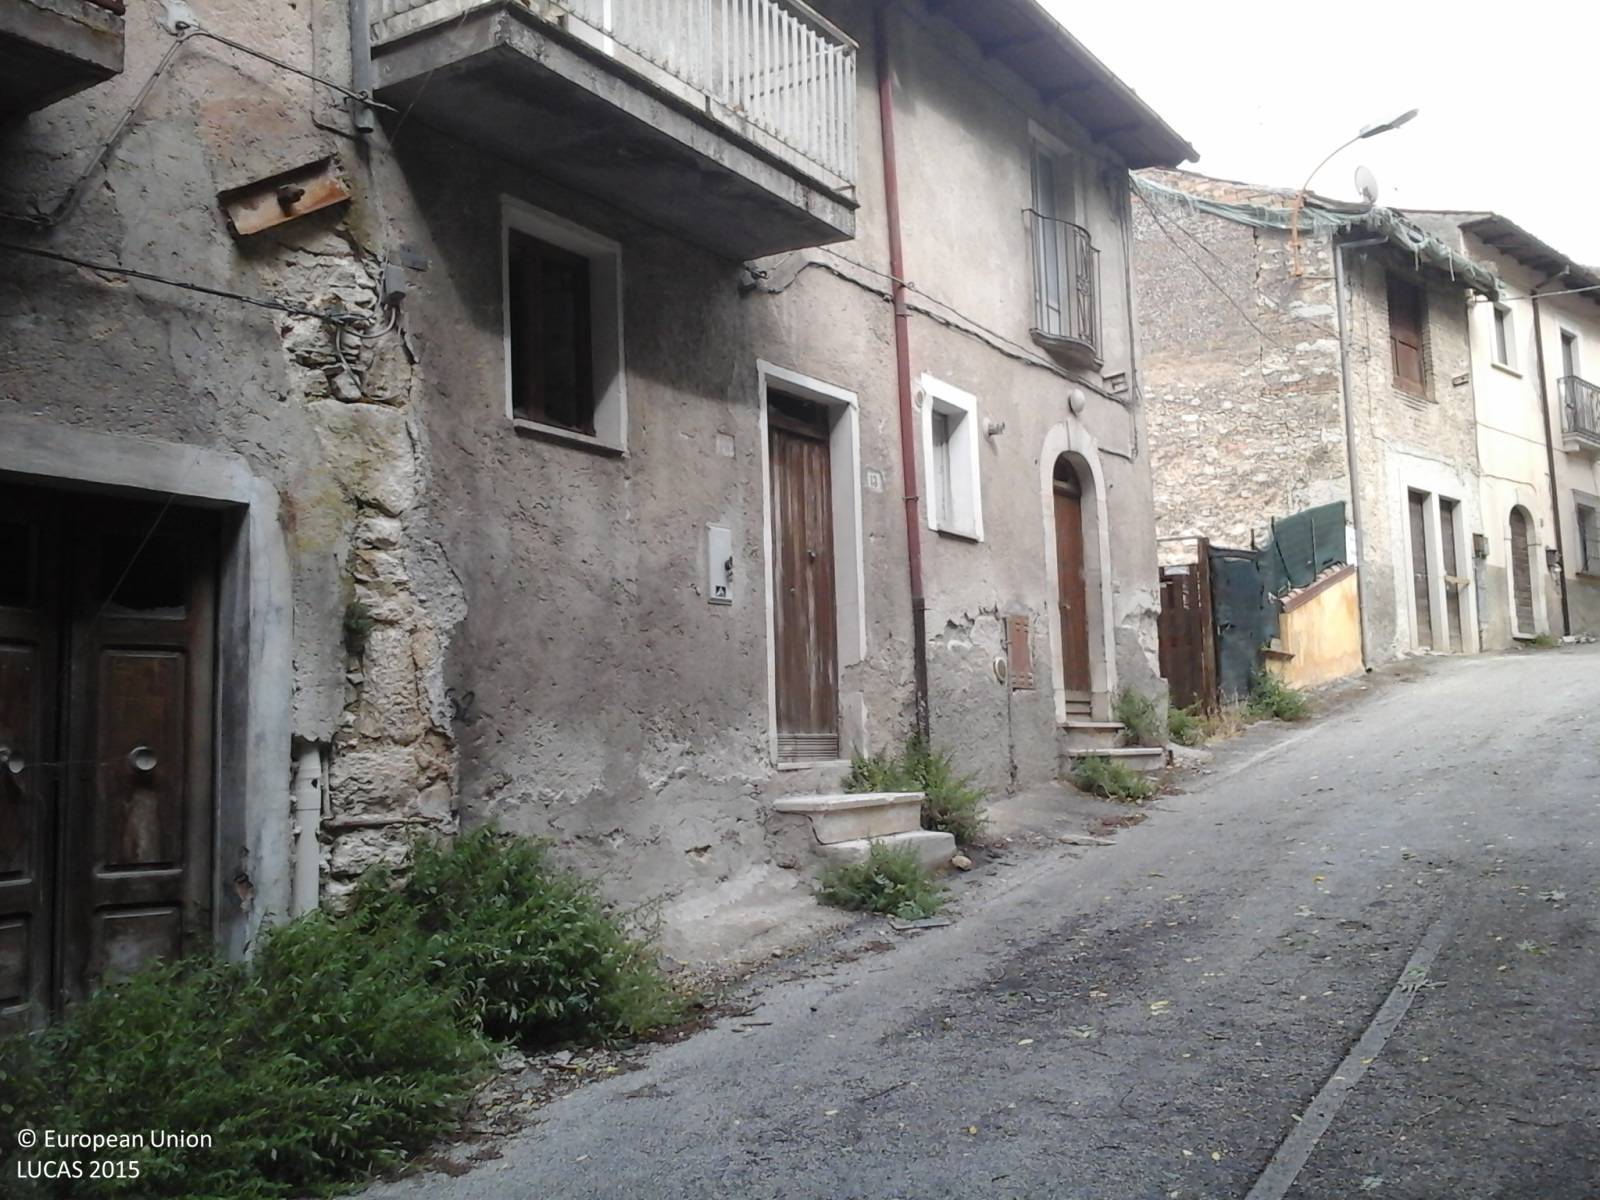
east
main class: Woodland
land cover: Broadleaved woodland
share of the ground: > 75 %
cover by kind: broadleaved forest trees 95 %, coniferous forest trees 5 %
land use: Amenities, museums, leisure
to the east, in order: Broadleaved woodland; Artificial constructions in urban areas; Shrubland without tree cover; Grassland without tree/shrub cover; Artificial constructions in urban areas
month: July
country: IT
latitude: 42.3595
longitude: 13.4734
